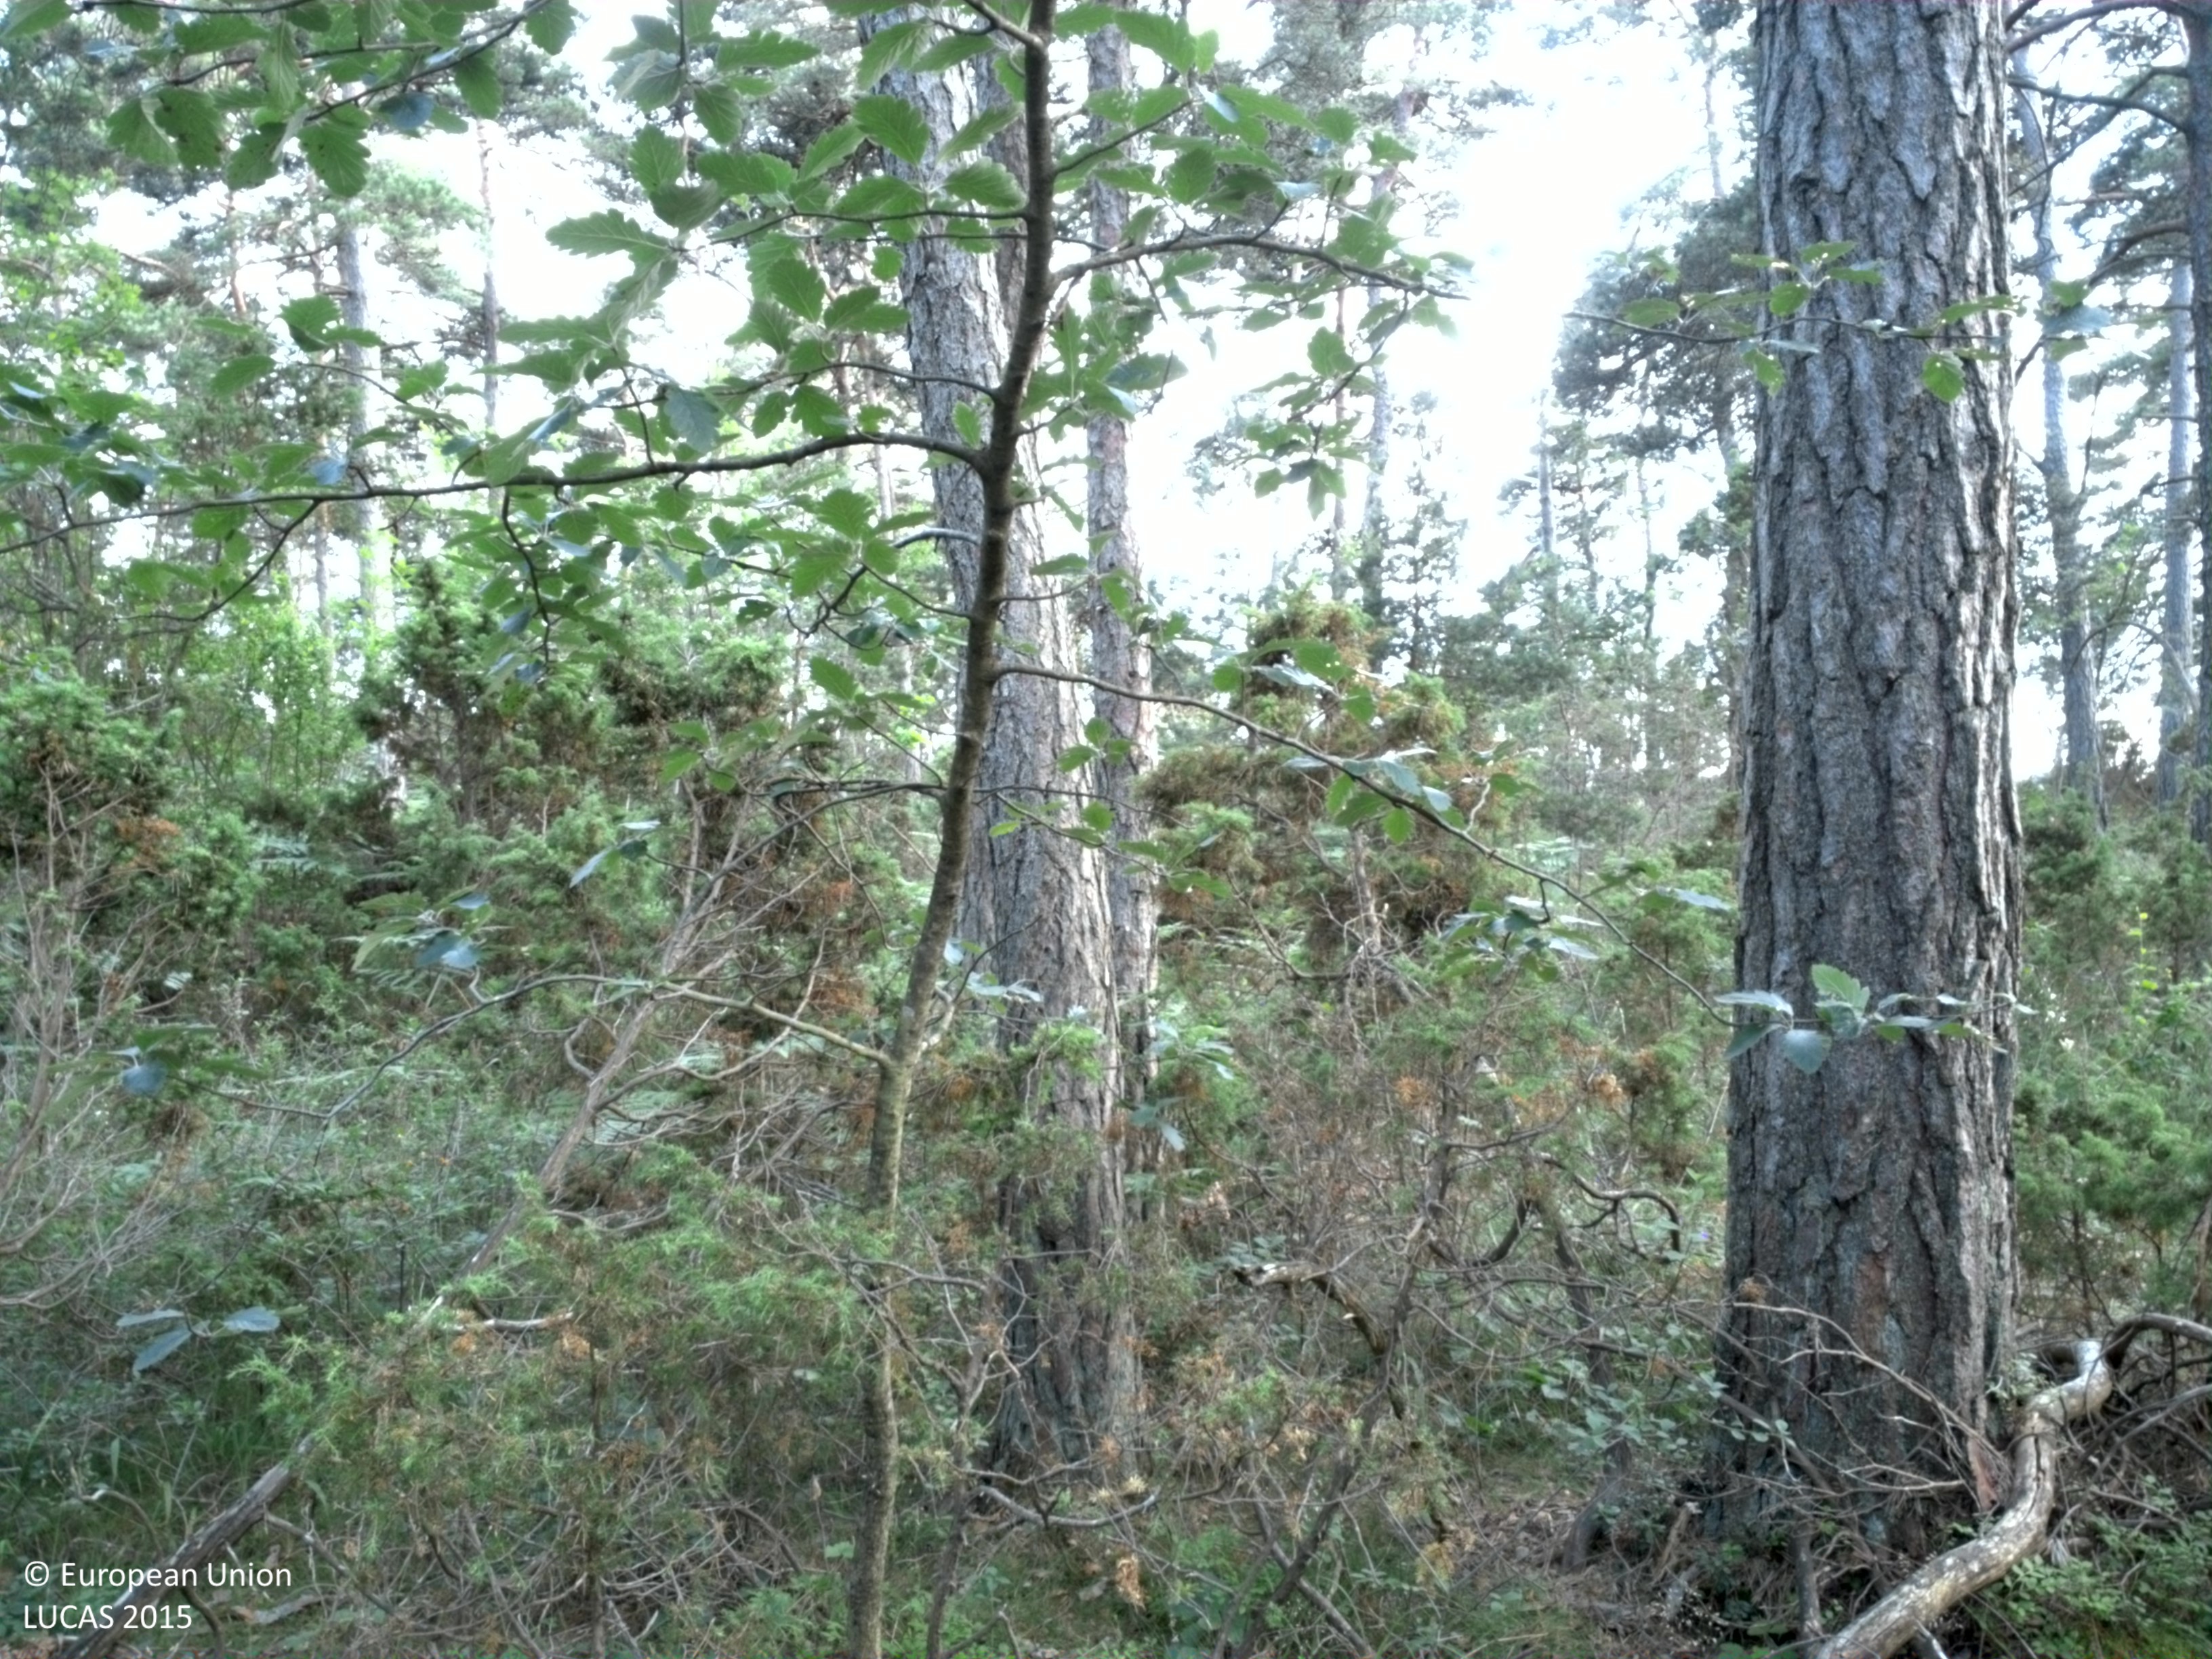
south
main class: Woodland
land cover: Pine dominated coniferous woodland
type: hemiboreal forest and nemoral coniferous forest and mixed broadleaved-coniferous forest
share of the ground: > 75 %
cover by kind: coniferous forest trees 75 %, shrubs 10 %, herbaceous plants 10 %, lichens and mosses 5 %
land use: Forestry
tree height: > 5 m
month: July
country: SE
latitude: 57.5657
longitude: 18.2821
